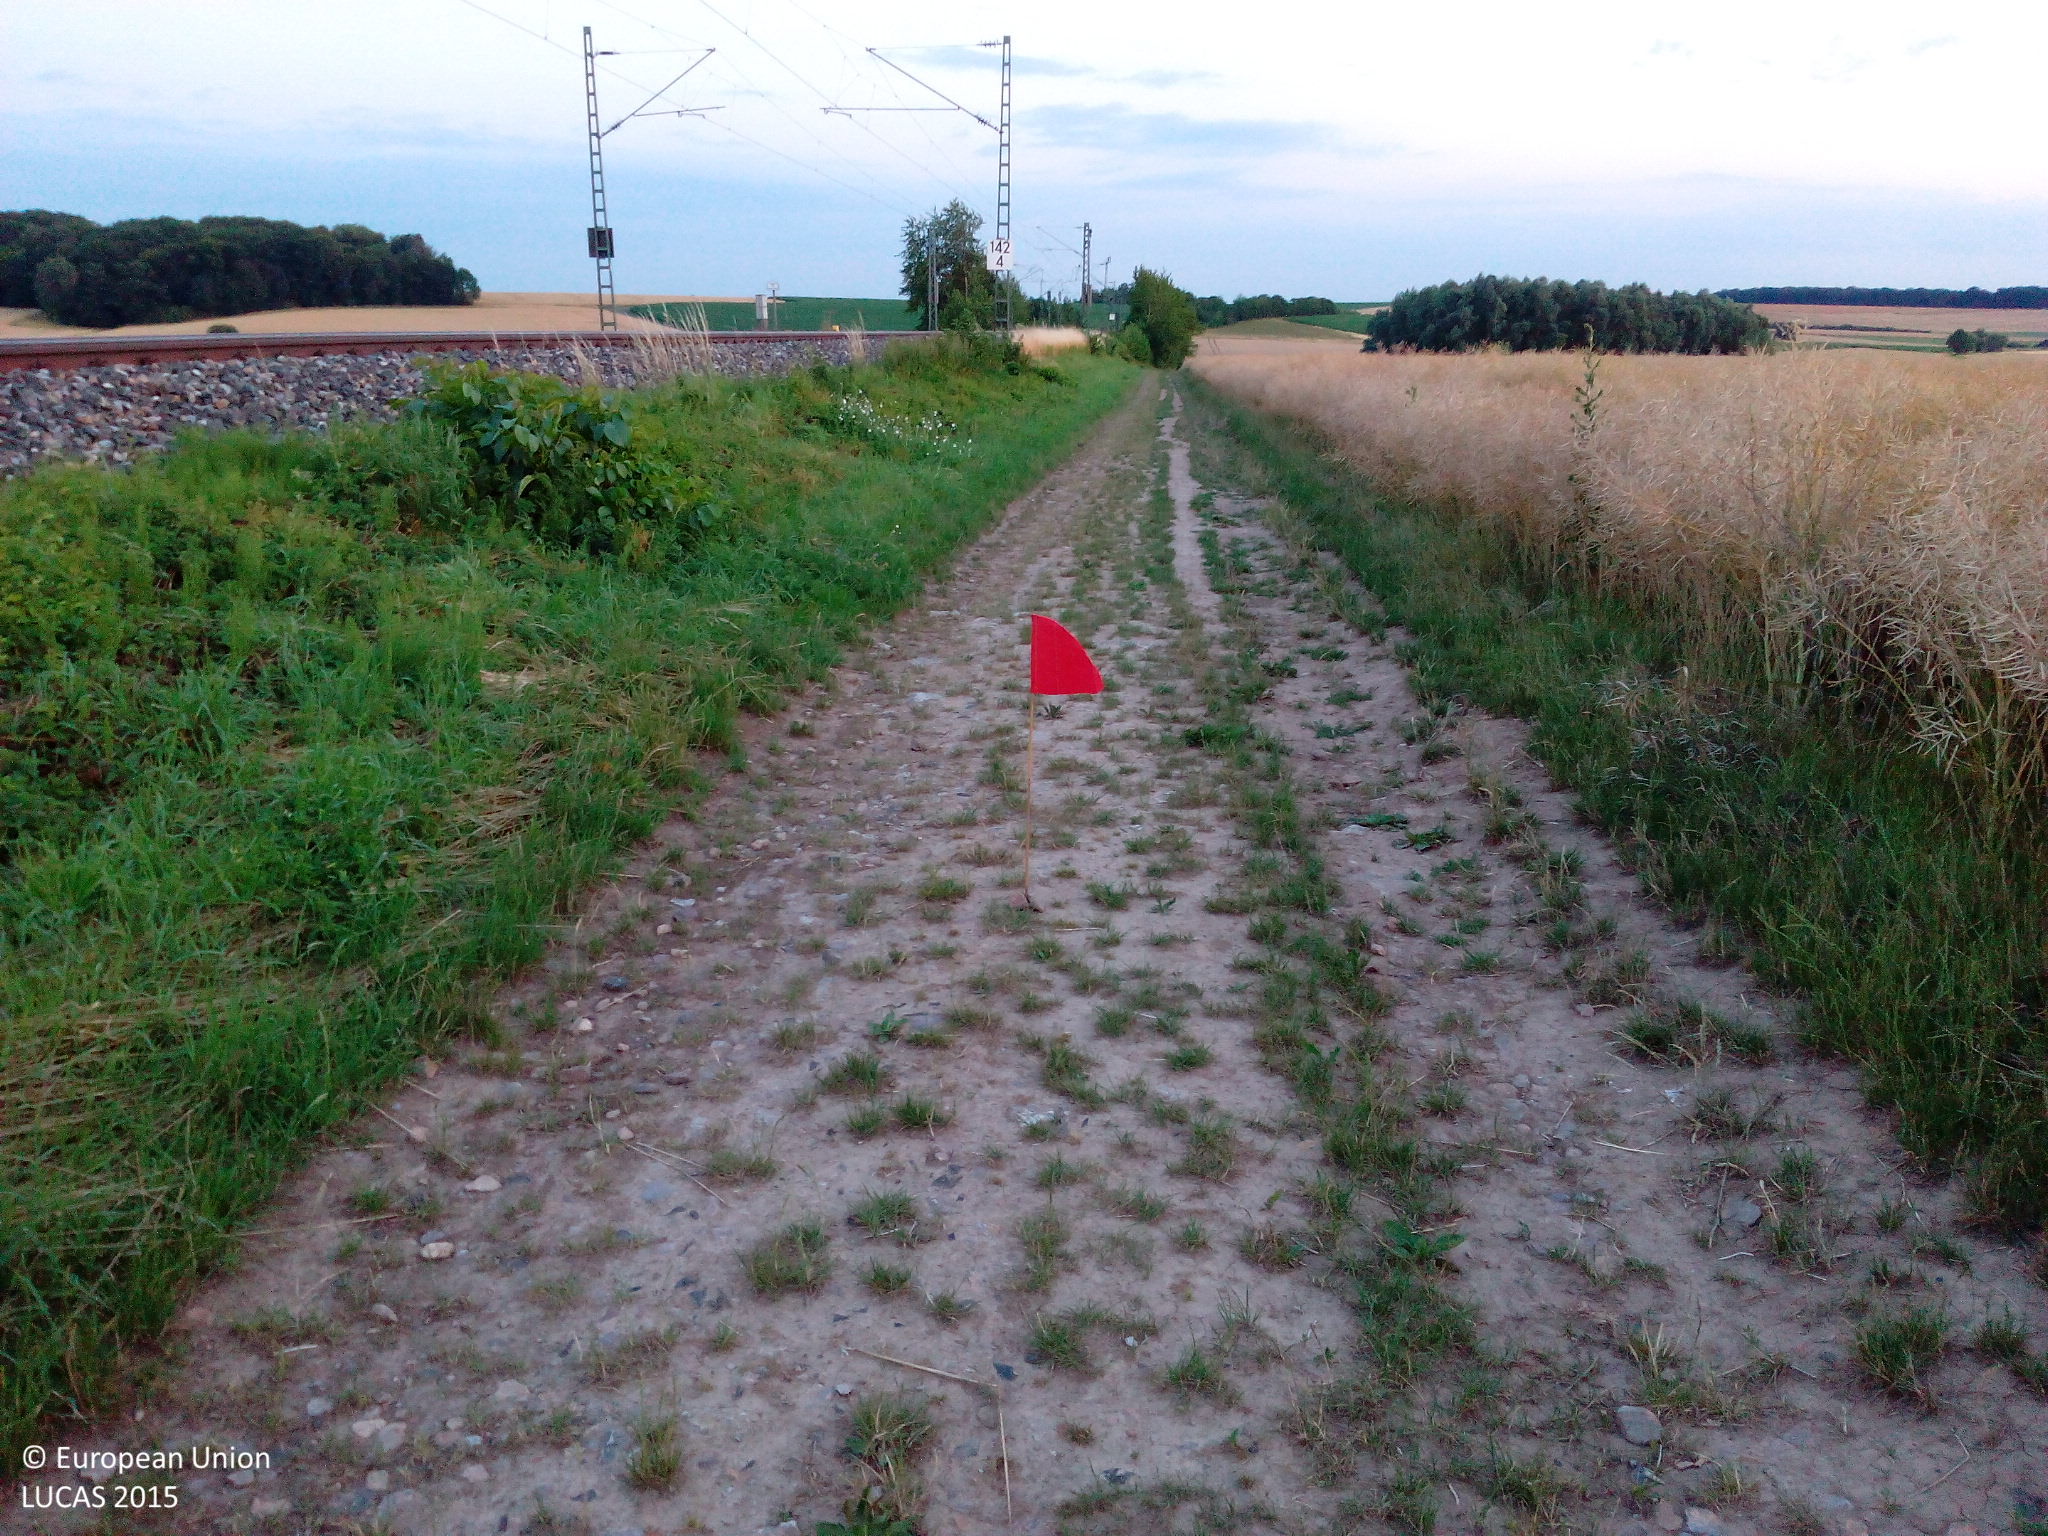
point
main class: Cropland
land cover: Rape and turnip rape
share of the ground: > 75 %
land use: Agriculture (excluding fallow land and kitchen gardens)
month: July
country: DE
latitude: 49.6806
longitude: 9.9030
